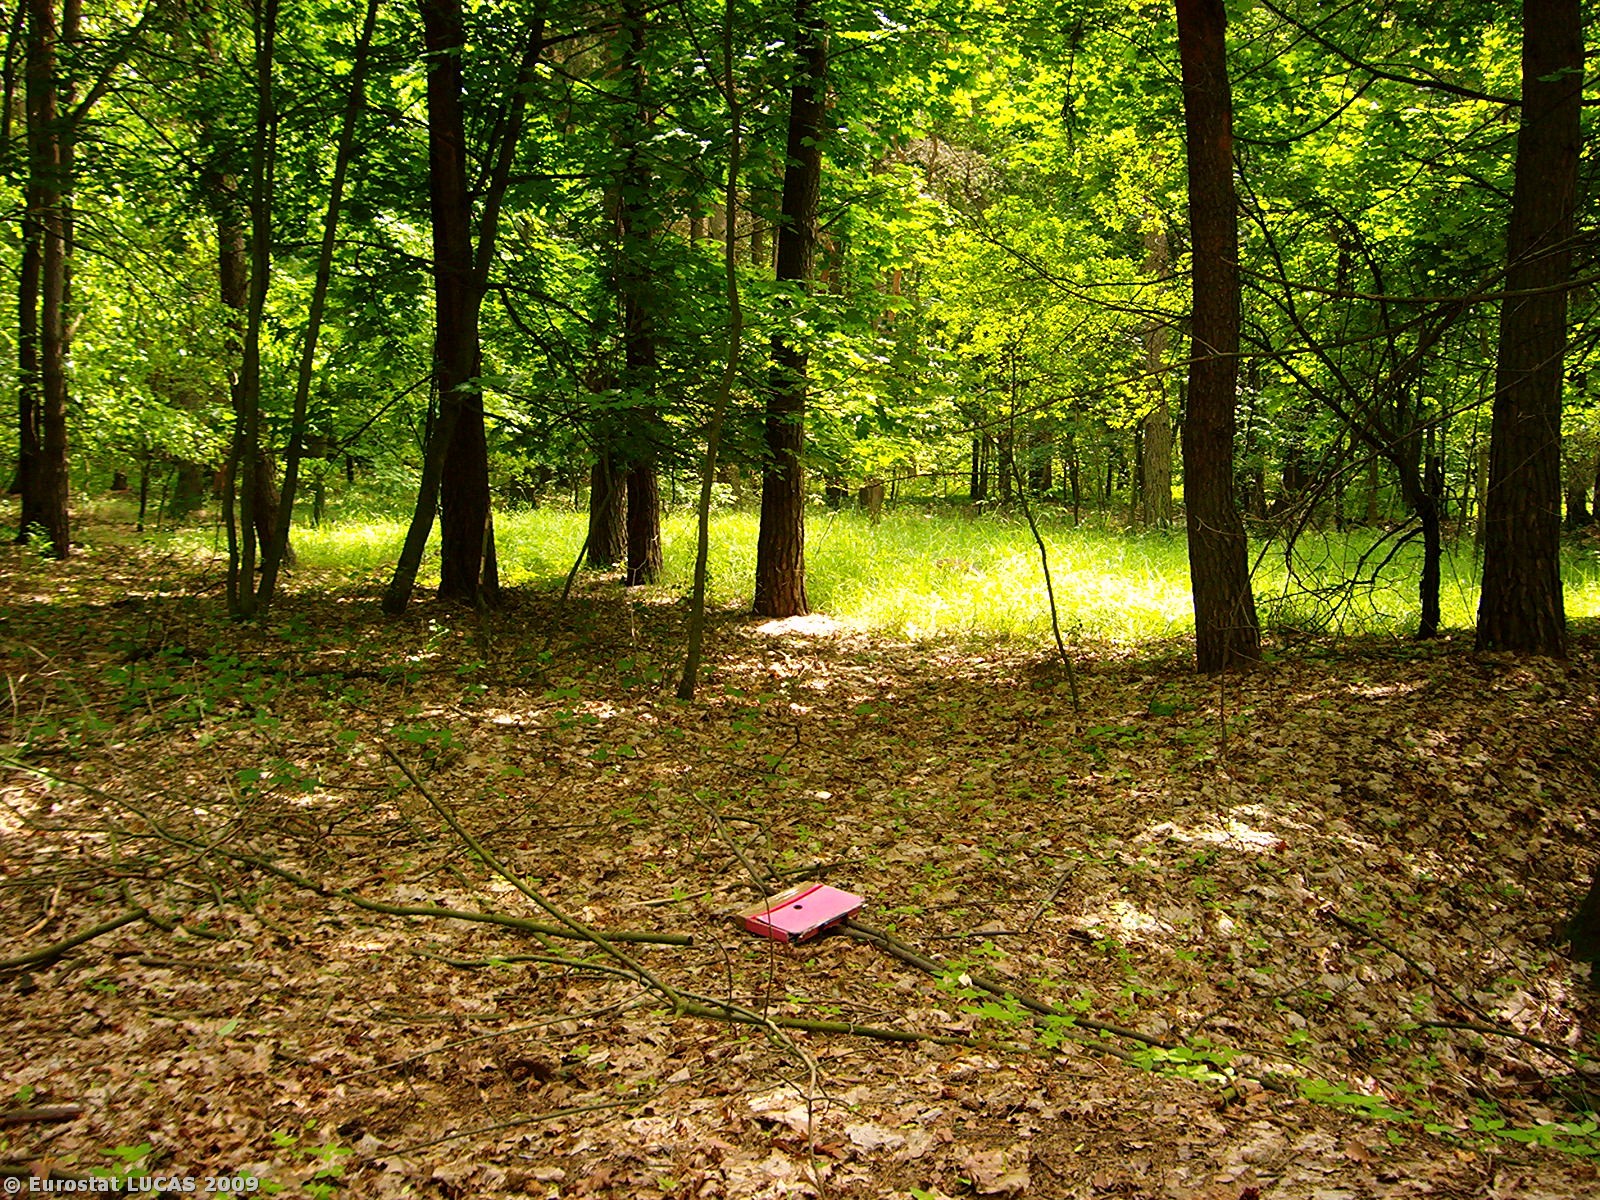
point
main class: Woodland
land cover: Mixed woodland
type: hemiboreal forest and nemoral coniferous forest and mixed broadleaved-coniferous forest
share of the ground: > 75 %
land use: Forestry
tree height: > 5 m
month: May
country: PL
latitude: 52.5327
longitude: 16.9825
